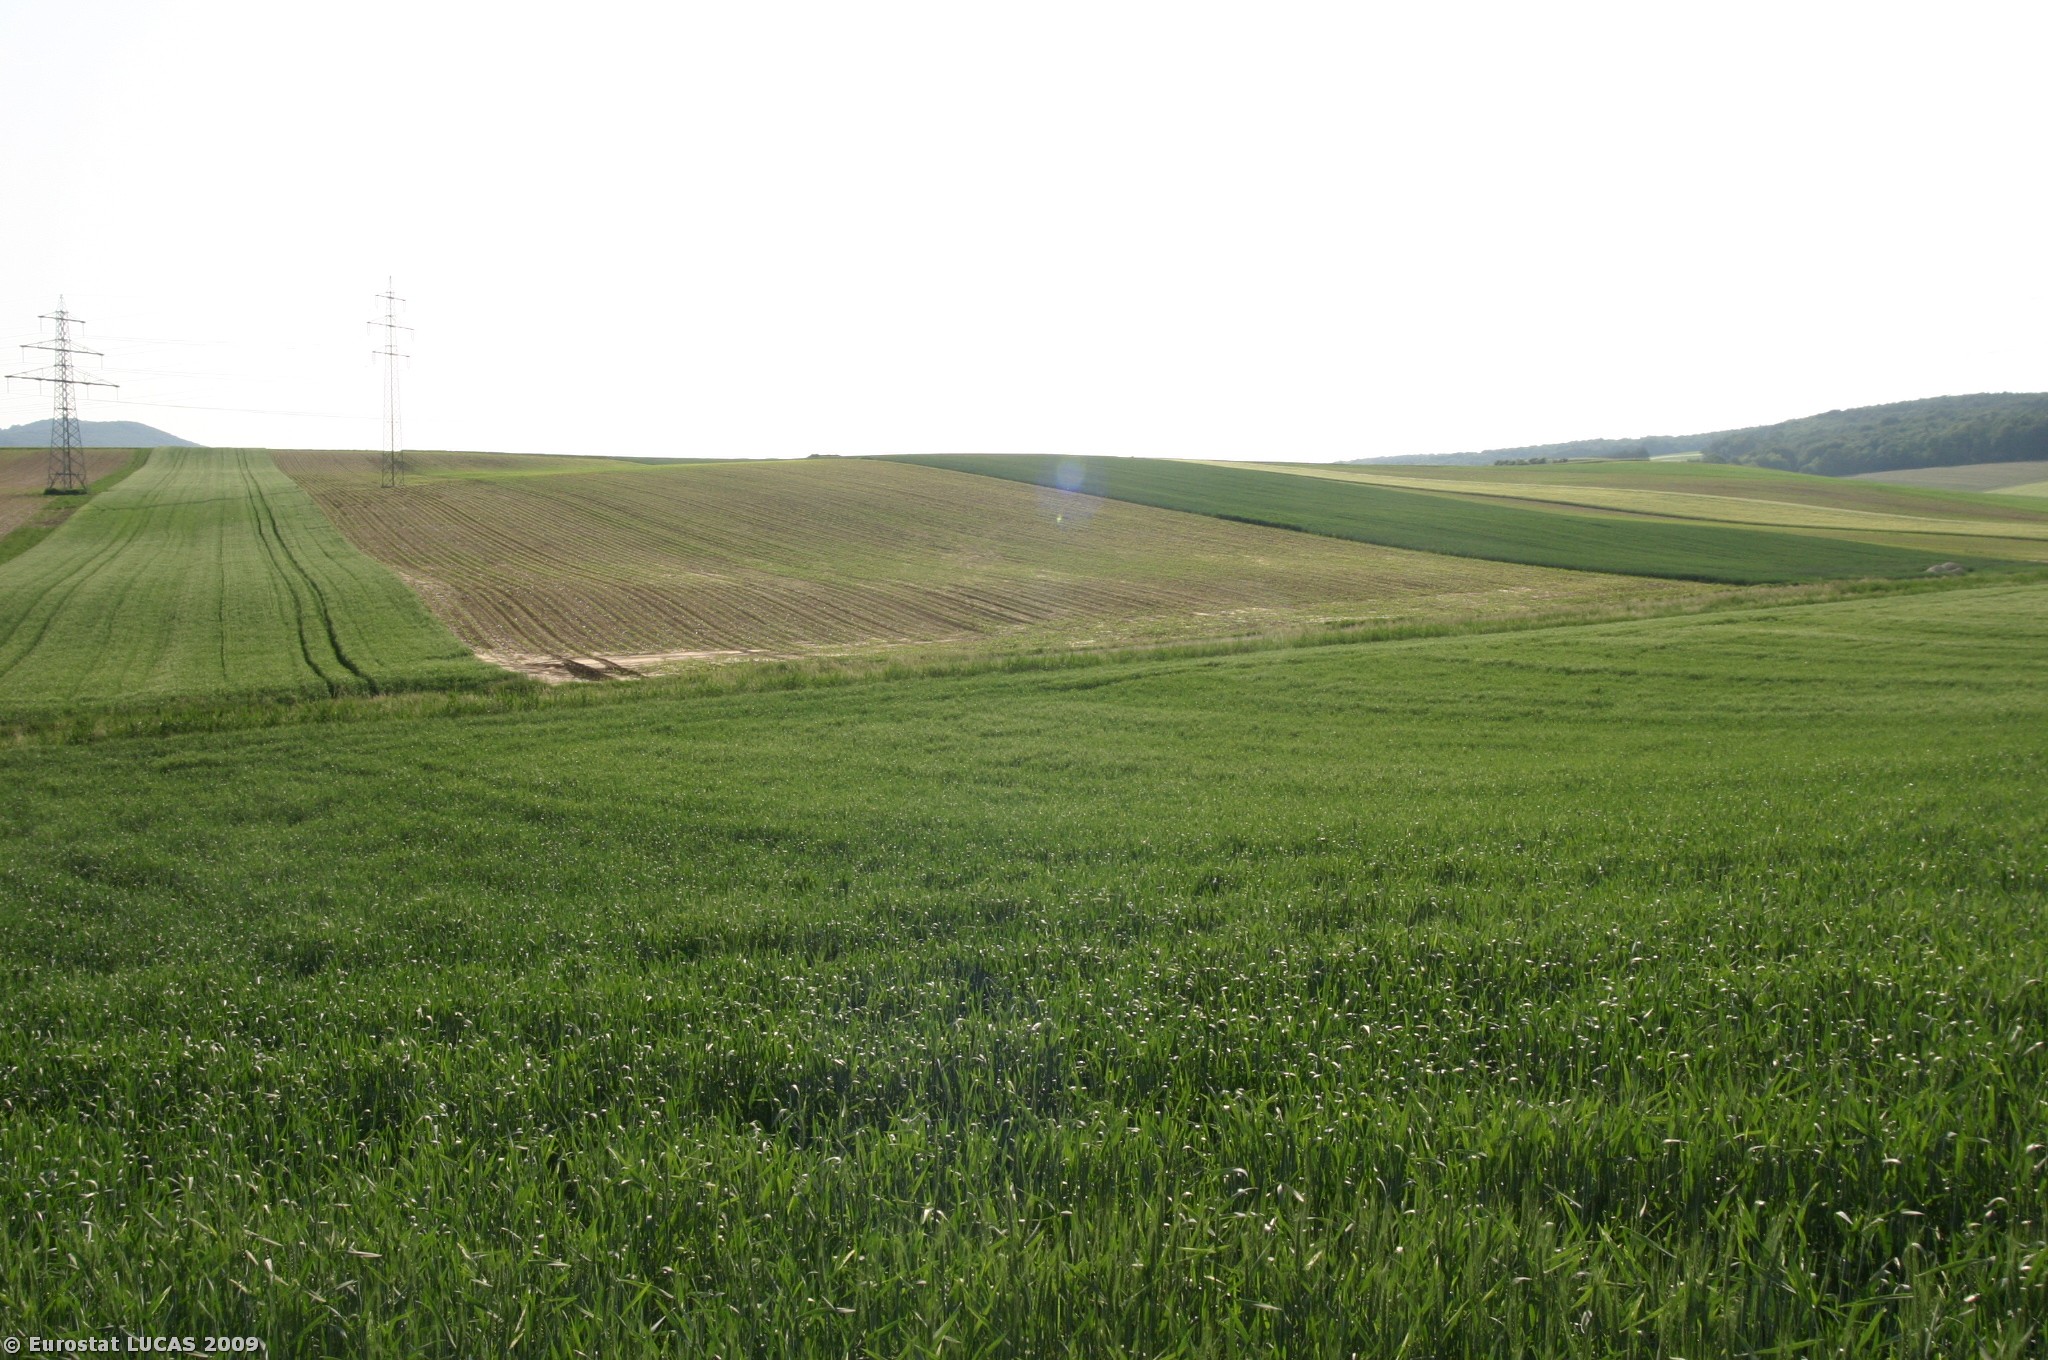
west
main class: Cropland
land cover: Triticale
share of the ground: > 75 %
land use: Agriculture (excluding fallow land and kitchen gardens)
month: May
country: AT
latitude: 48.2408
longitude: 15.9958
